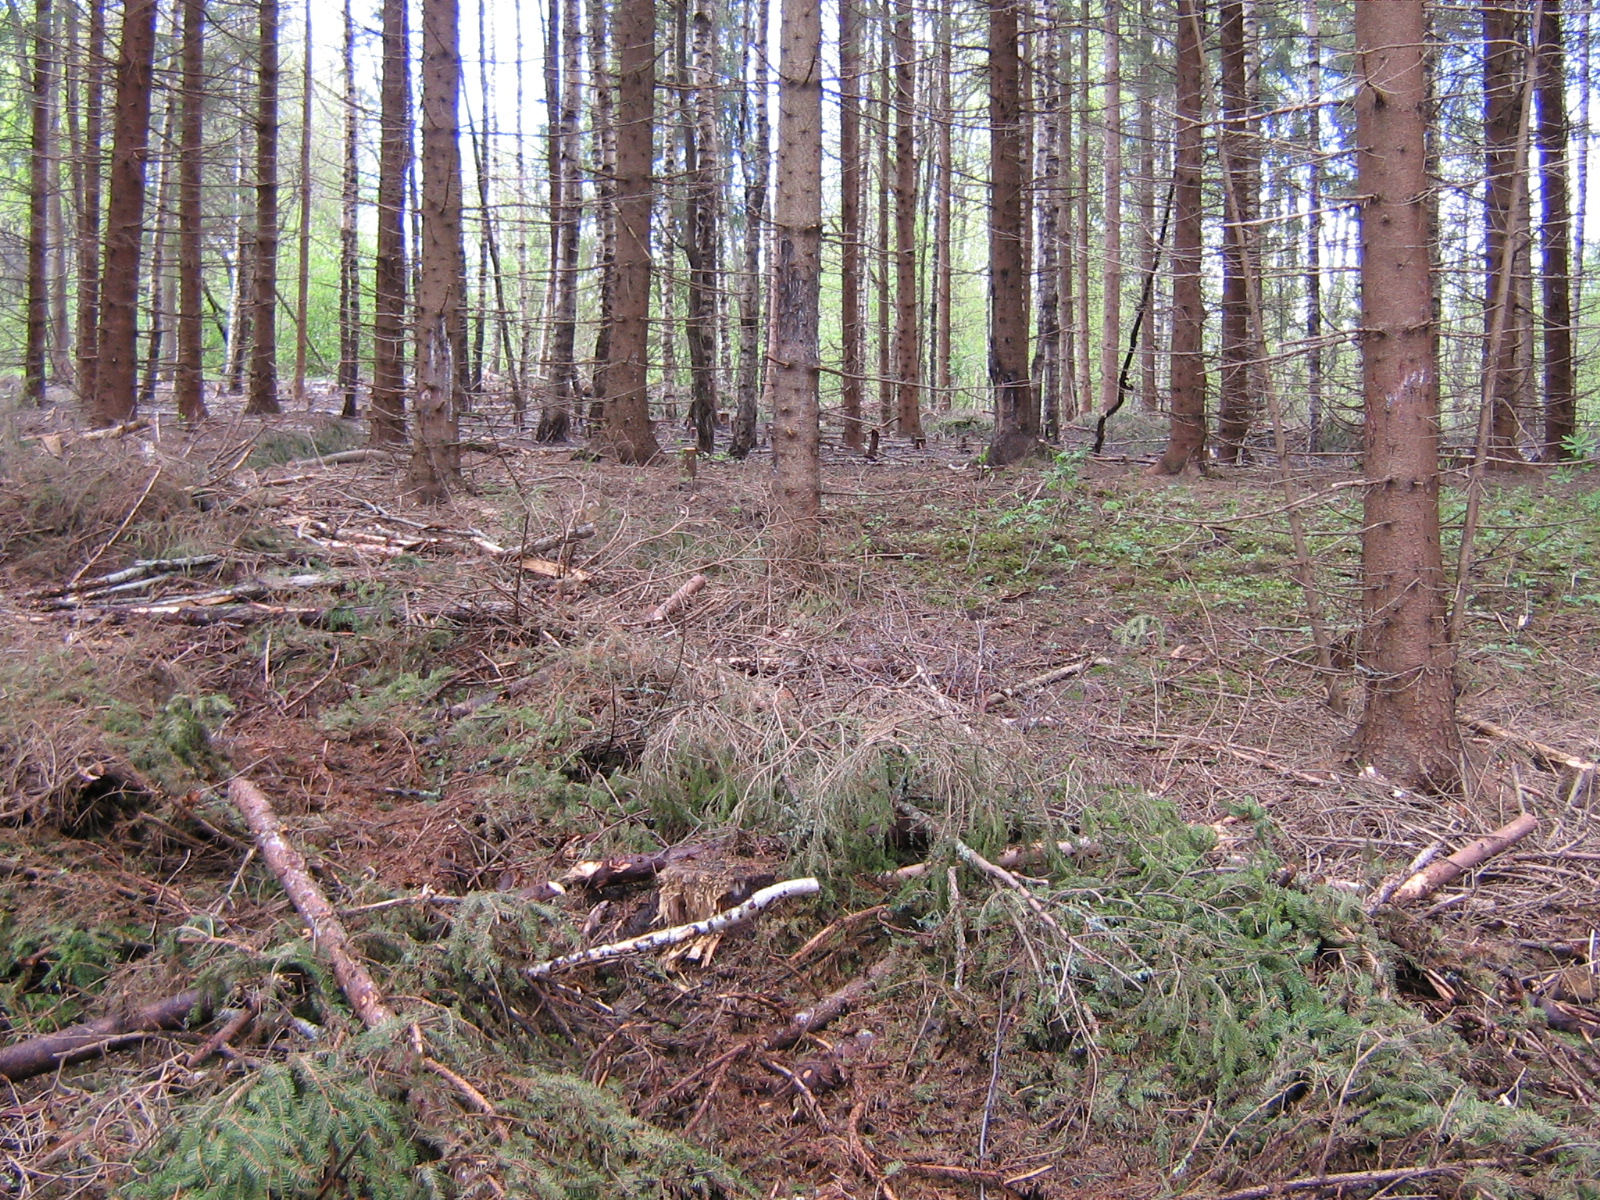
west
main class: Woodland
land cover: Spruce dominated mixed woodland
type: hemiboreal forest and nemoral coniferous forest and mixed broadleaved-coniferous forest
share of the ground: > 75 %
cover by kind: coniferous forest trees 70 %, broadleaved forest trees 30 %
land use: Forestry
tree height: > 5 m
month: May
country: LV
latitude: 57.1811
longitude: 25.5190
